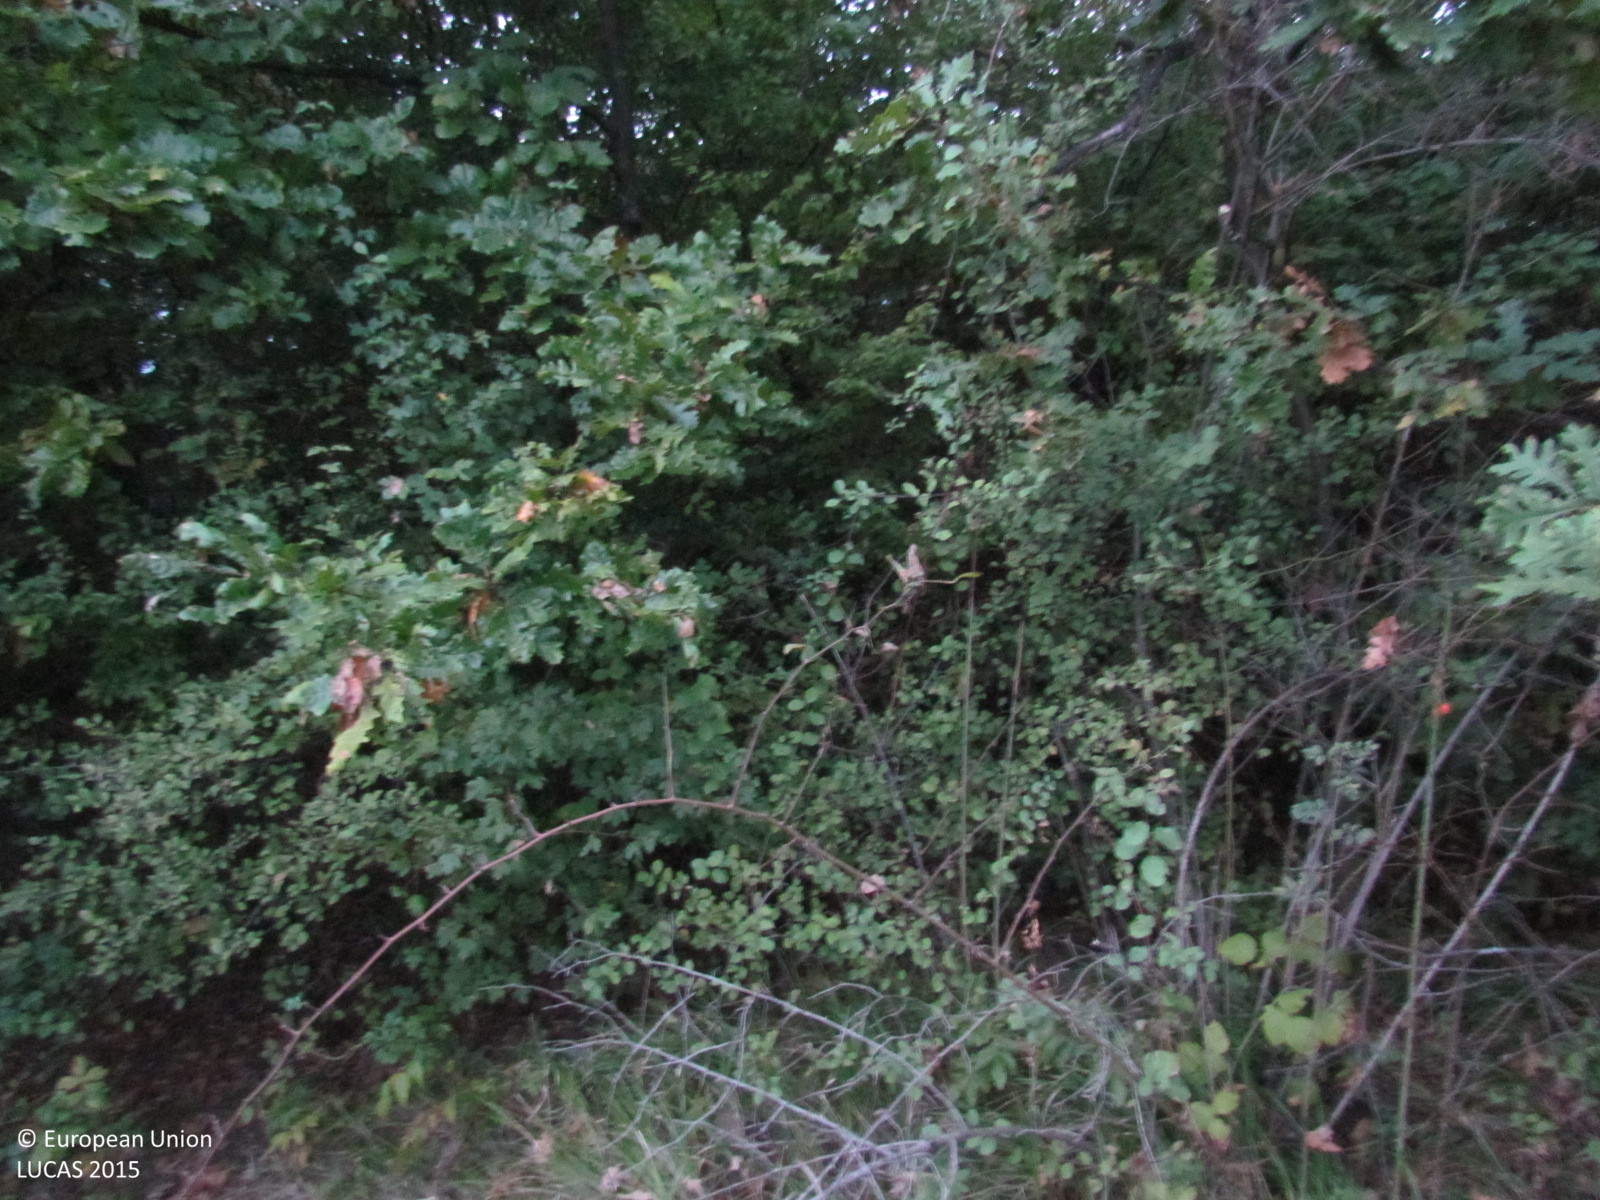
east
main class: Woodland
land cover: Broadleaved woodland
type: acidophilous oak and oak-birch forest
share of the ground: > 75 %
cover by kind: broadleaved forest trees 80 %, shrubs 10 %, herbaceous plants 10 %
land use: Forestry
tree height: > 5 m
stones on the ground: < 10 %
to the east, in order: Broadleaved woodland; Shrubland with sparse tree cover; Tracks; Shrubland with sparse tree cover; Tracks; Shrubland with sparse tree cover; Tracks; Shrubland with sparse tree cover; Vineyards
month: October
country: BG
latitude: 42.6989
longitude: 26.7643
